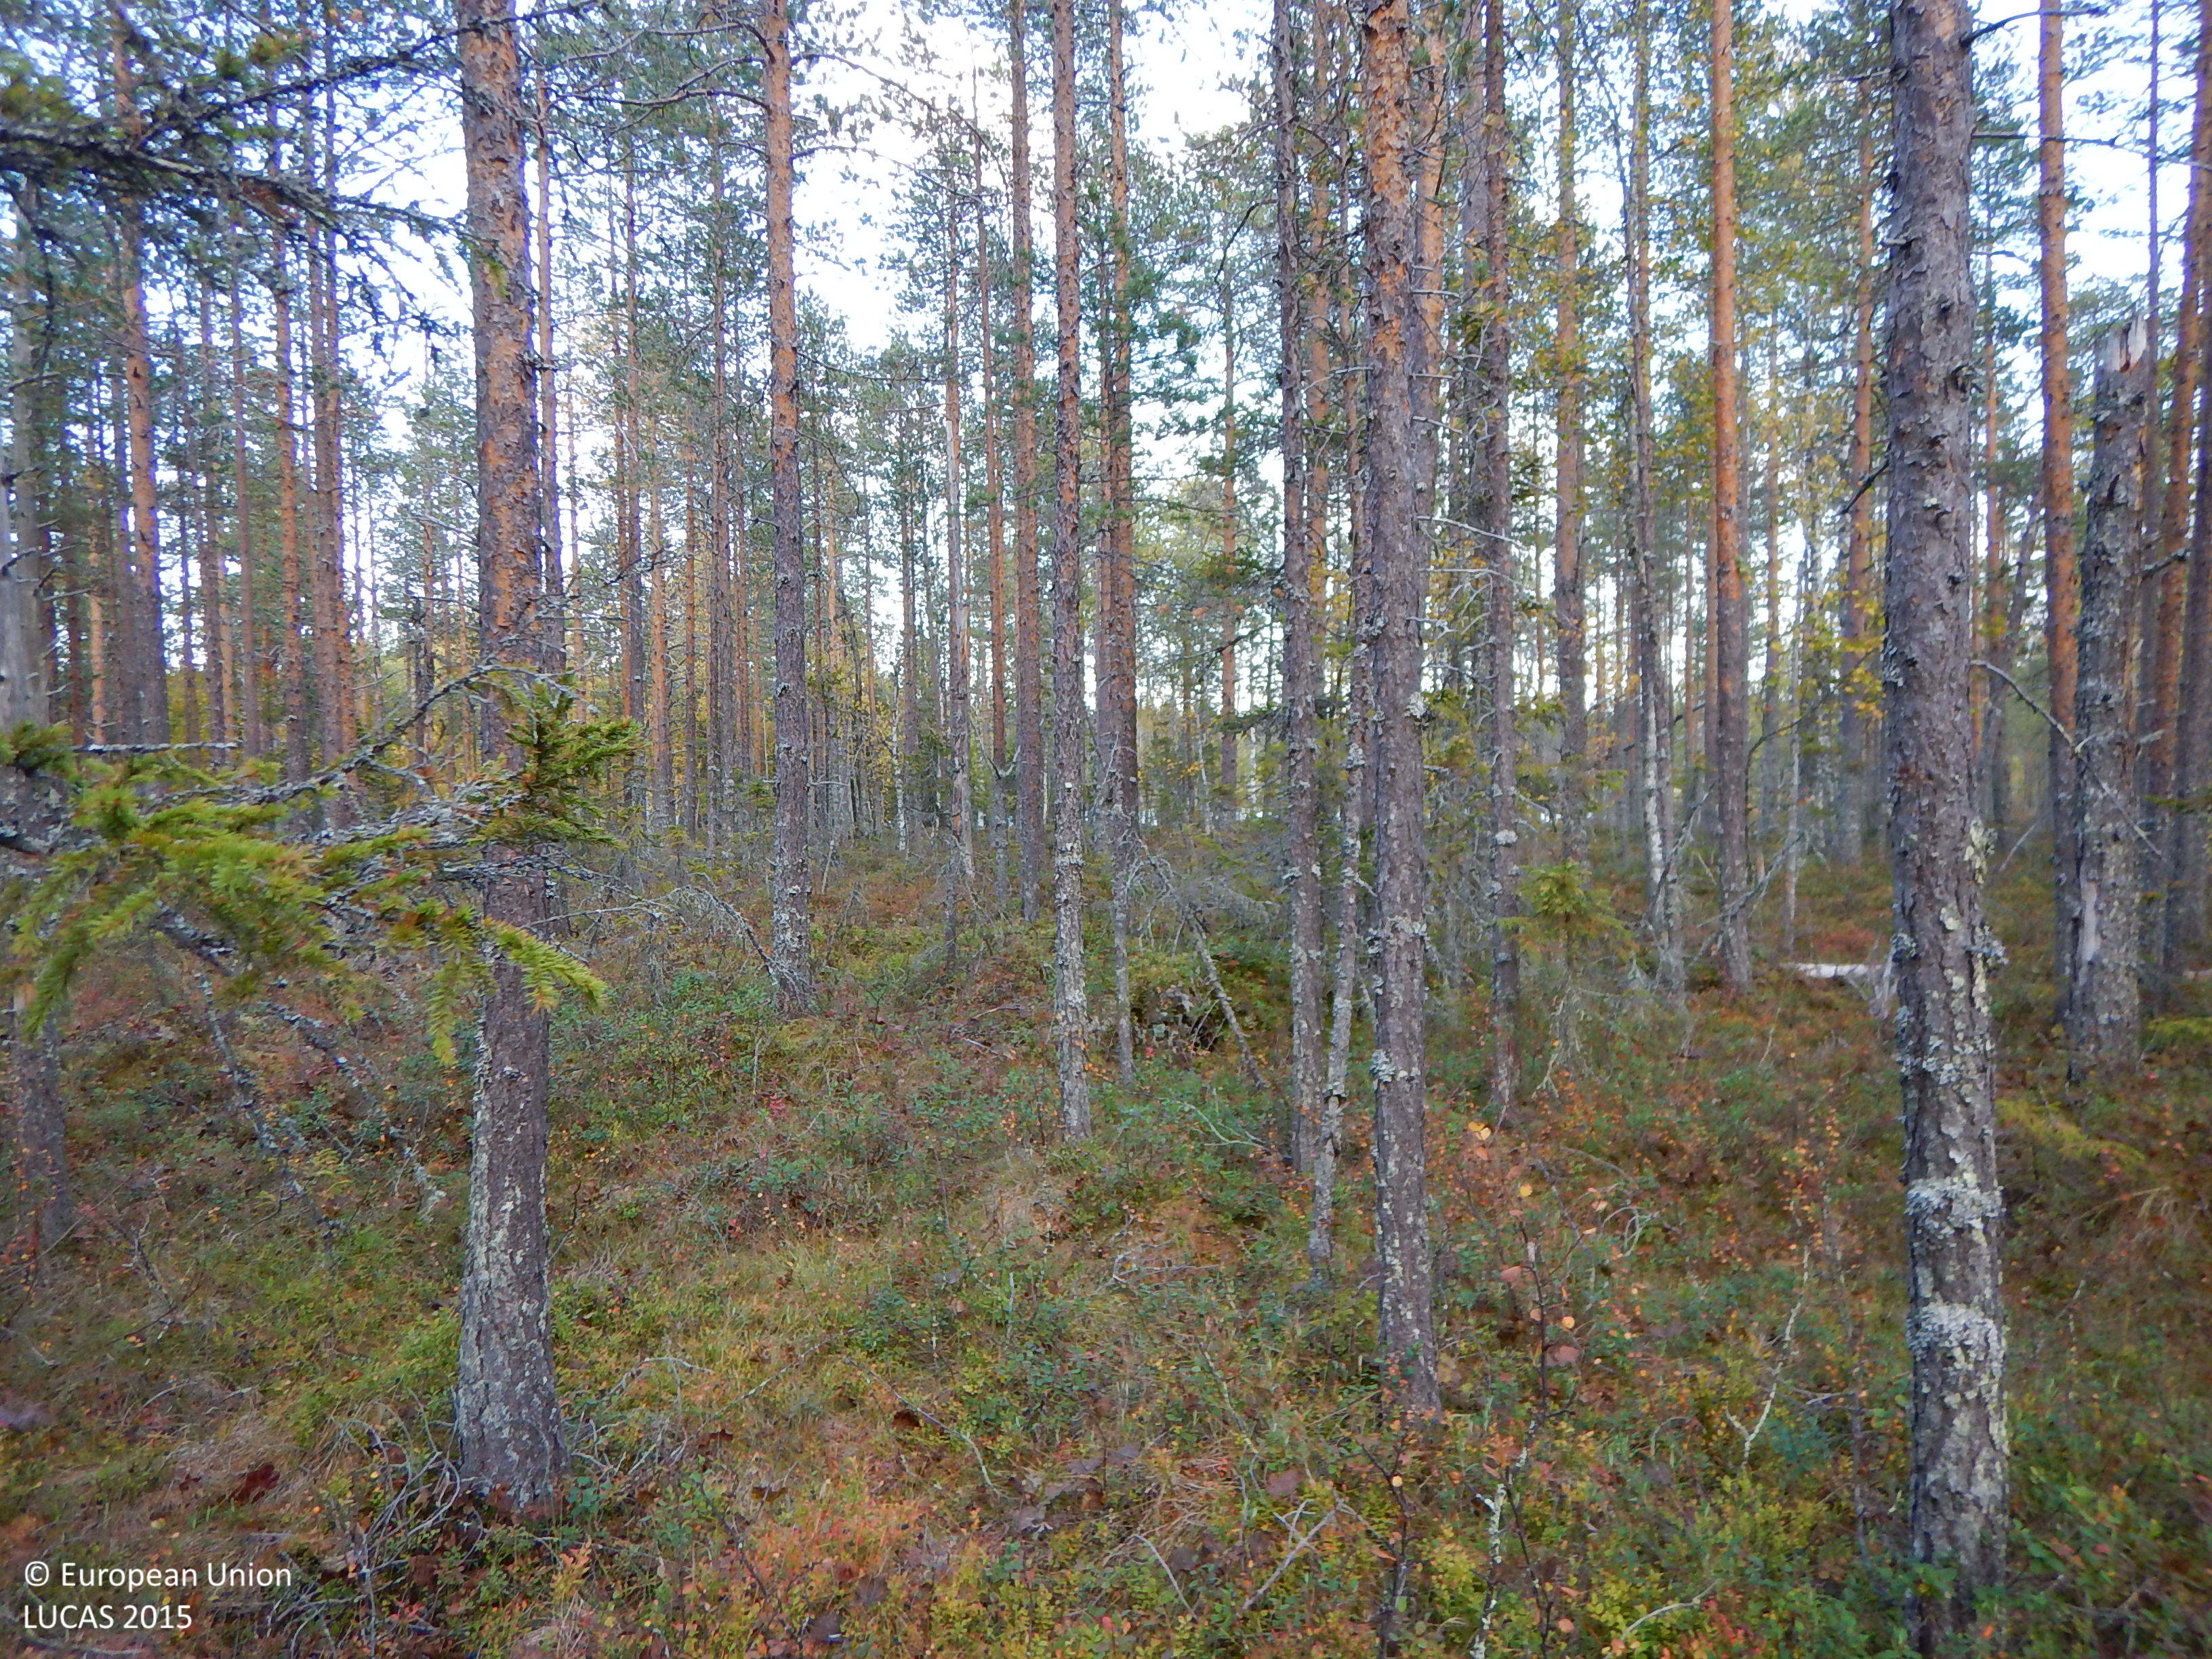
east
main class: Woodland
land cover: Pine dominated coniferous woodland
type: boreal forest
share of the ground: 25 - 50 %
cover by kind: coniferous forest trees 35 %, shrubs 25 %, lichens and mosses 20 %, herbaceous plants 15 %, broadleaved forest trees 5 %
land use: Forestry
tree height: > 5 m
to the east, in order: Pine dominated coniferous woodland; Ditches and canals; Pine dominated coniferous woodland; Tracks; Pine dominated coniferous woodland; Inland marshes; Inland fresh water bodies; Inland marshes; Other mixed woodland
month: September
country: SE
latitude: 64.6750
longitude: 20.1352
